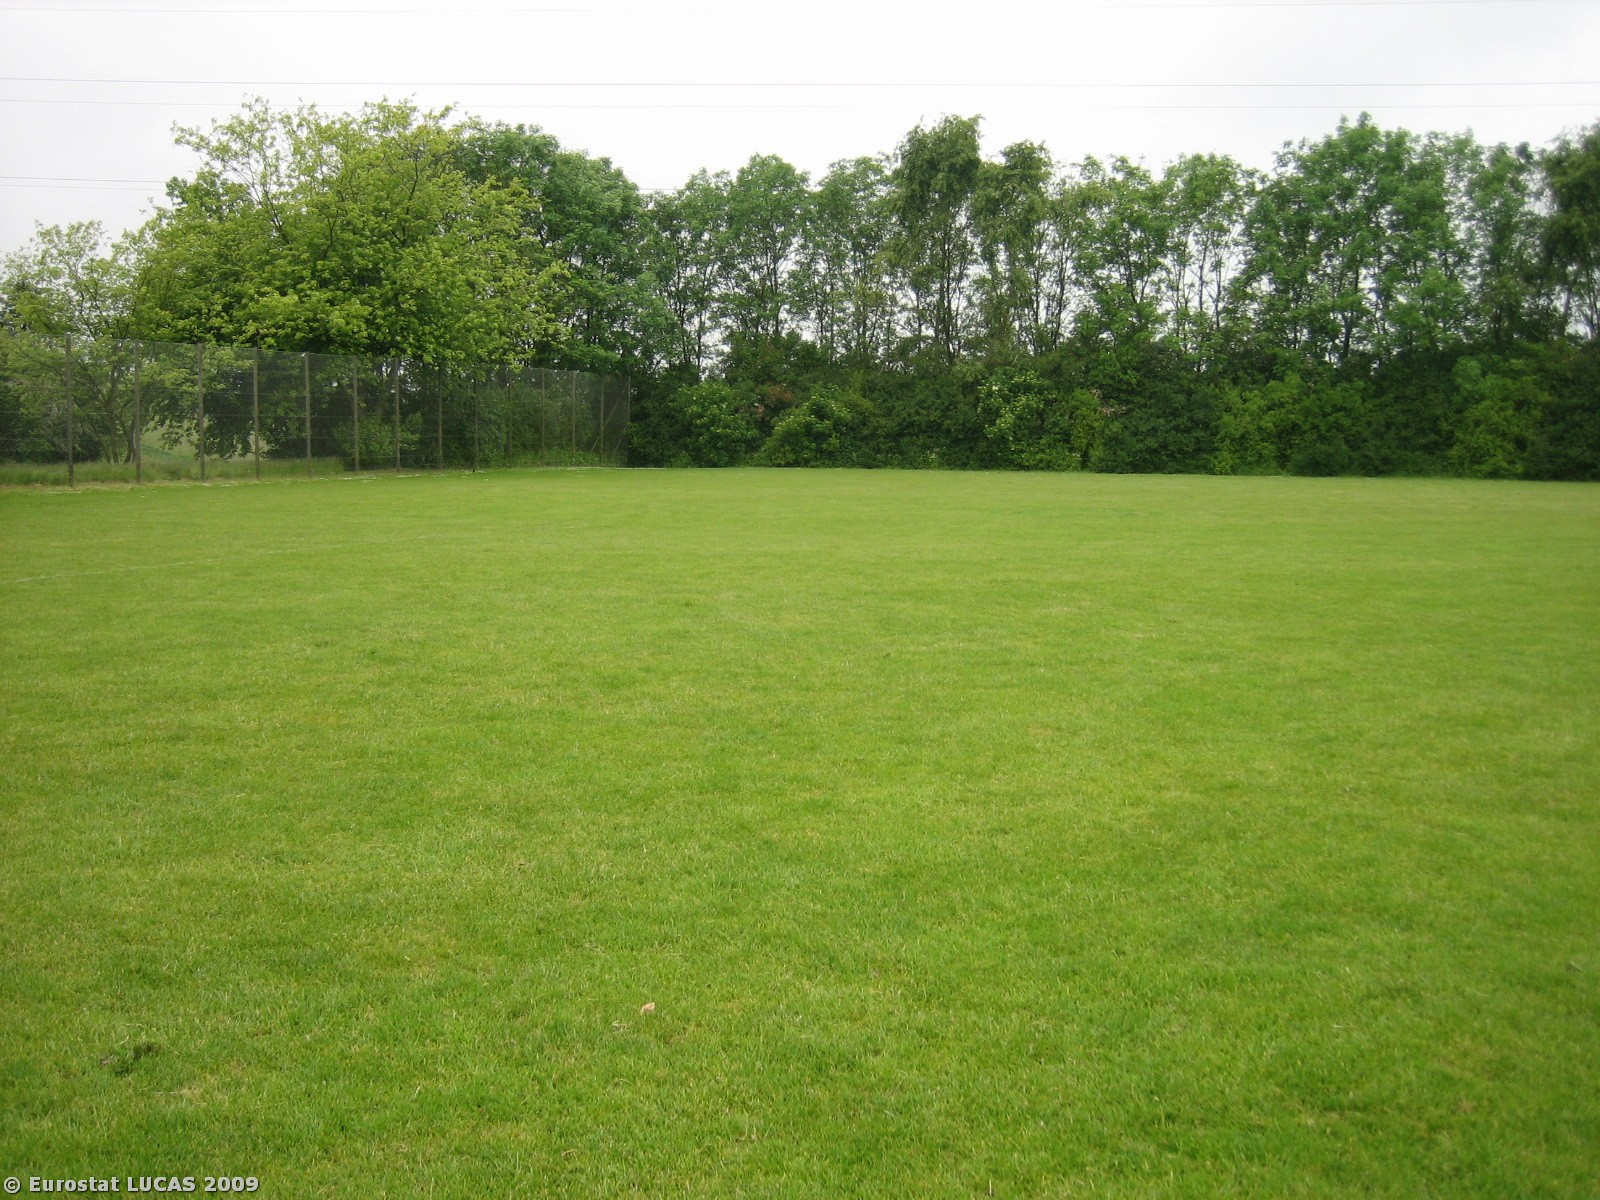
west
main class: Grassland
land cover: Grassland without tree/shrub cover
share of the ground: > 75 %
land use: Sport
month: June
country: DK
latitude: 56.1697
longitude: 10.1448
